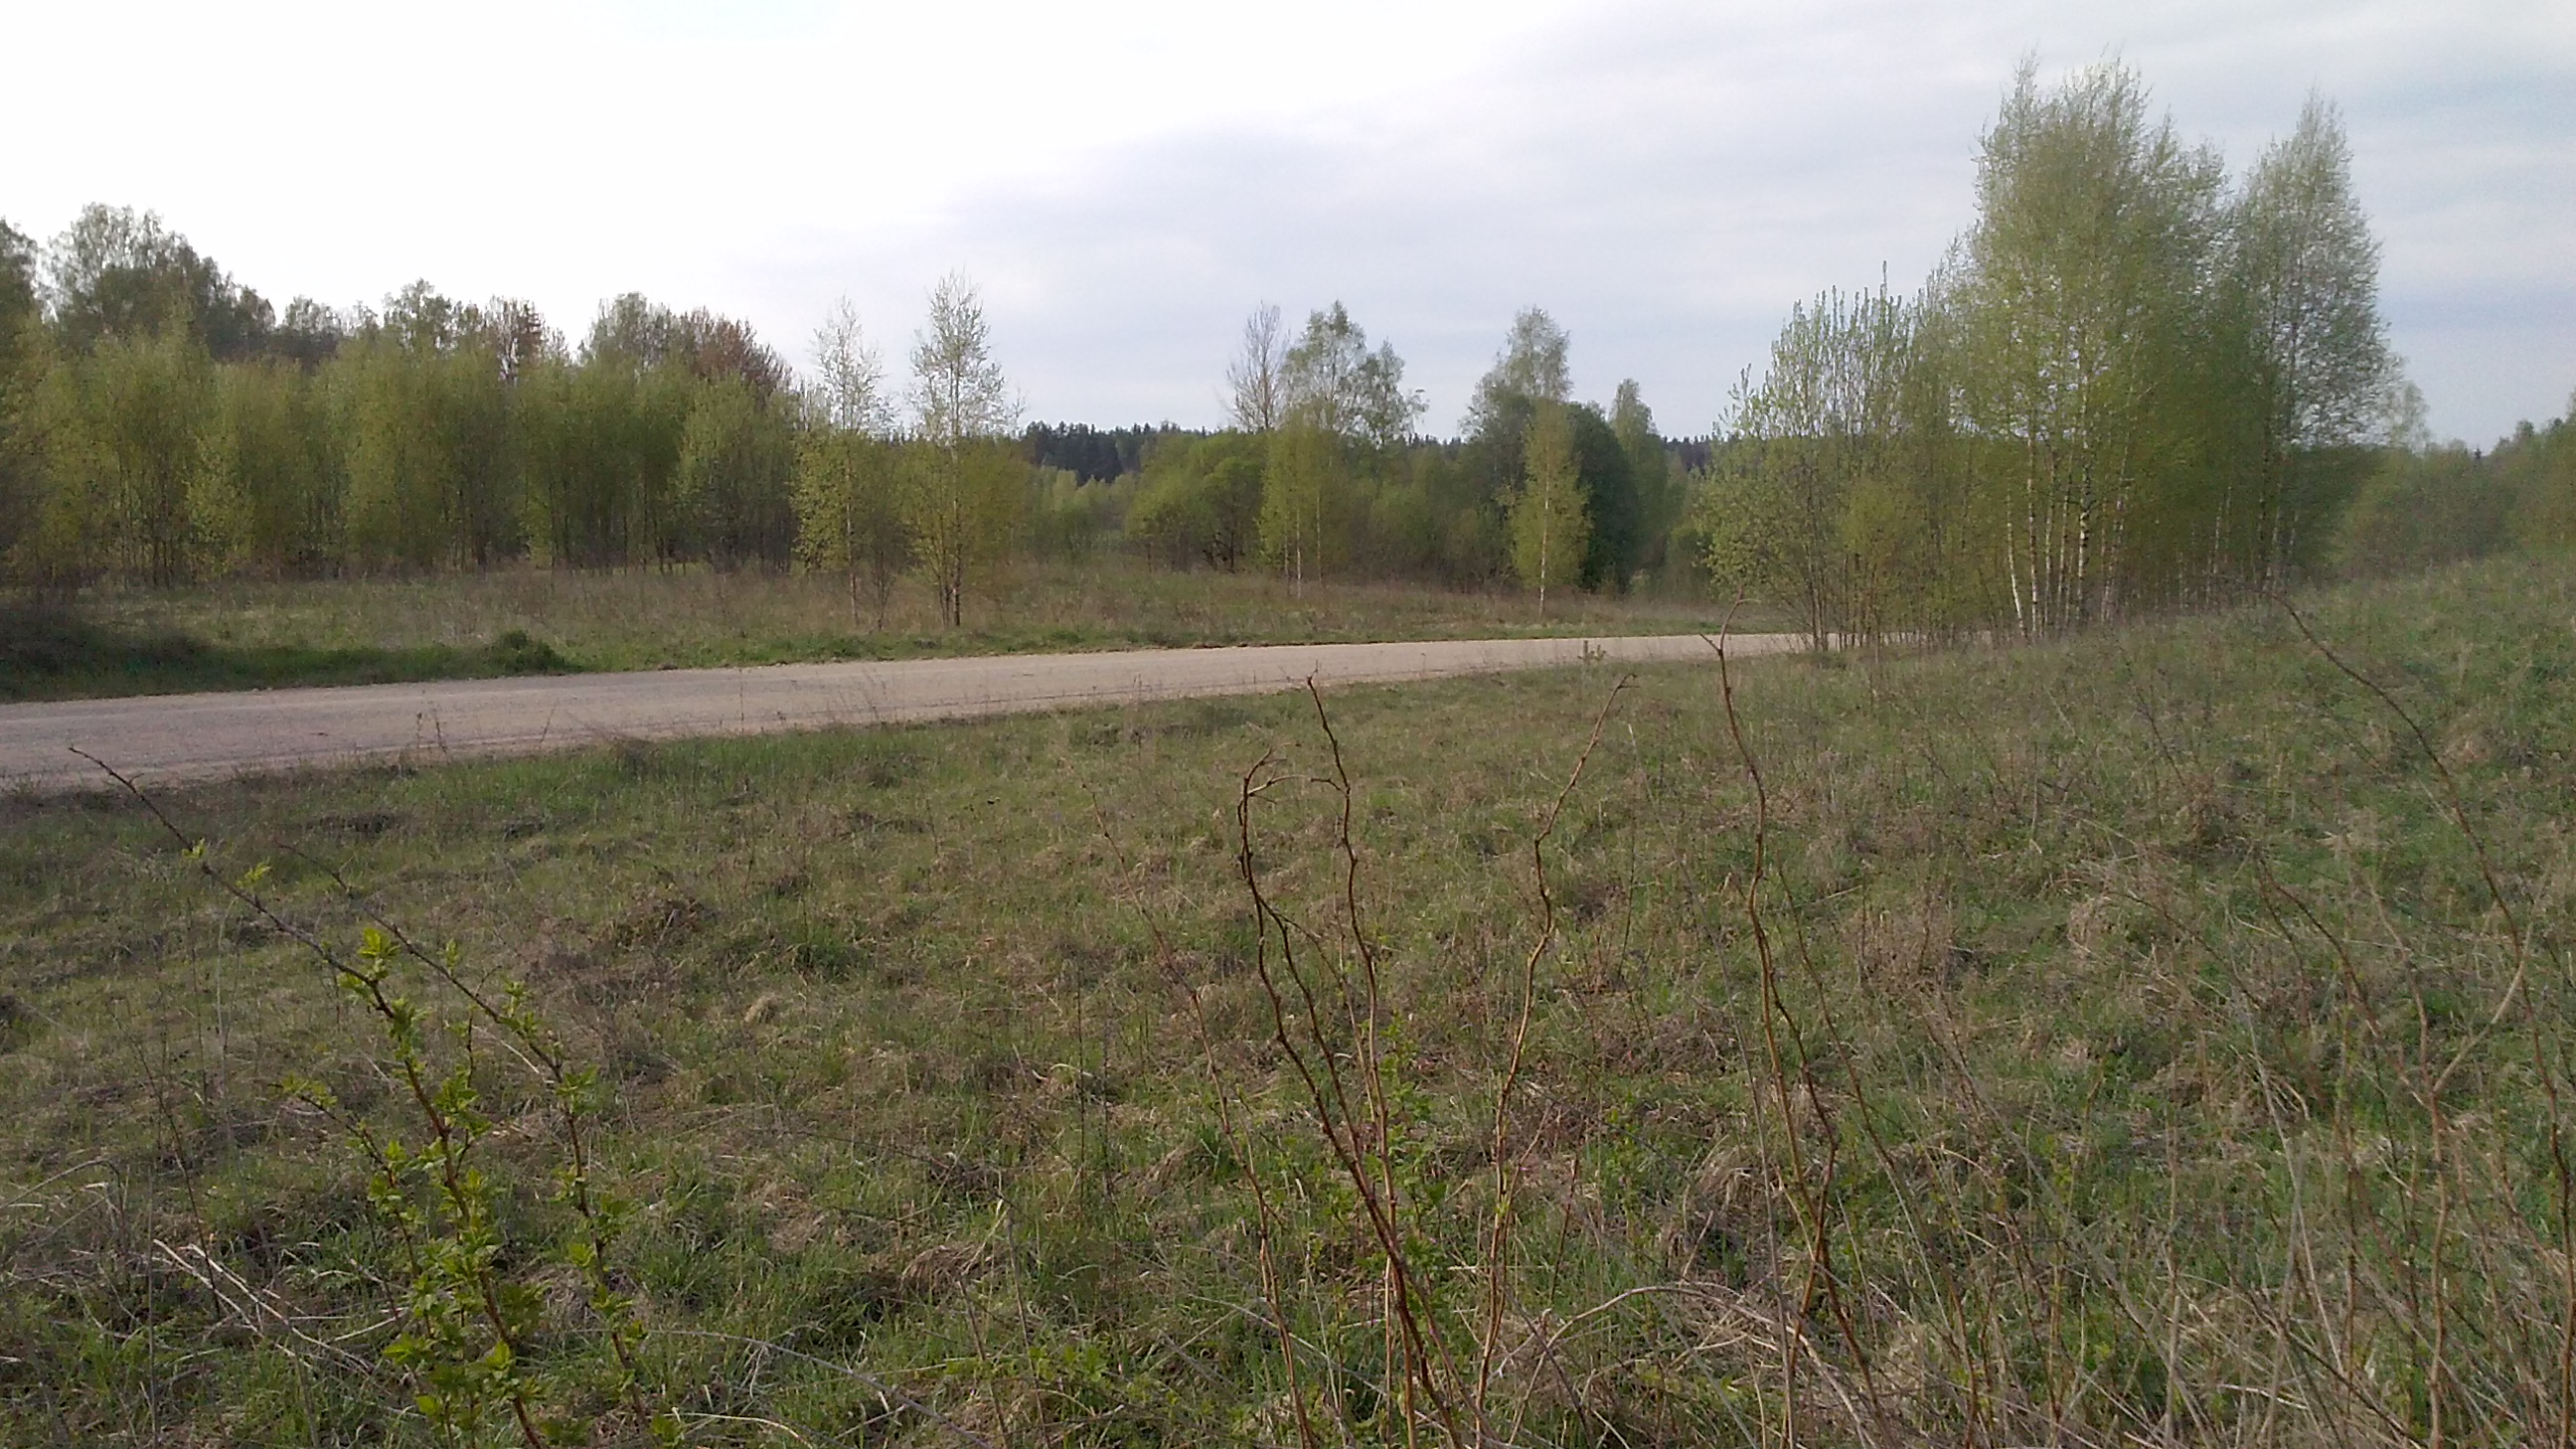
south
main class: Woodland
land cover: Broadleaved woodland
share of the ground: 10 - 25 %
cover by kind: herbaceous plants 80 %, broadleaved forest trees 20 %
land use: Semi-natural and natural areas not in use
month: May
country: LV
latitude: 55.9142
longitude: 27.0795
